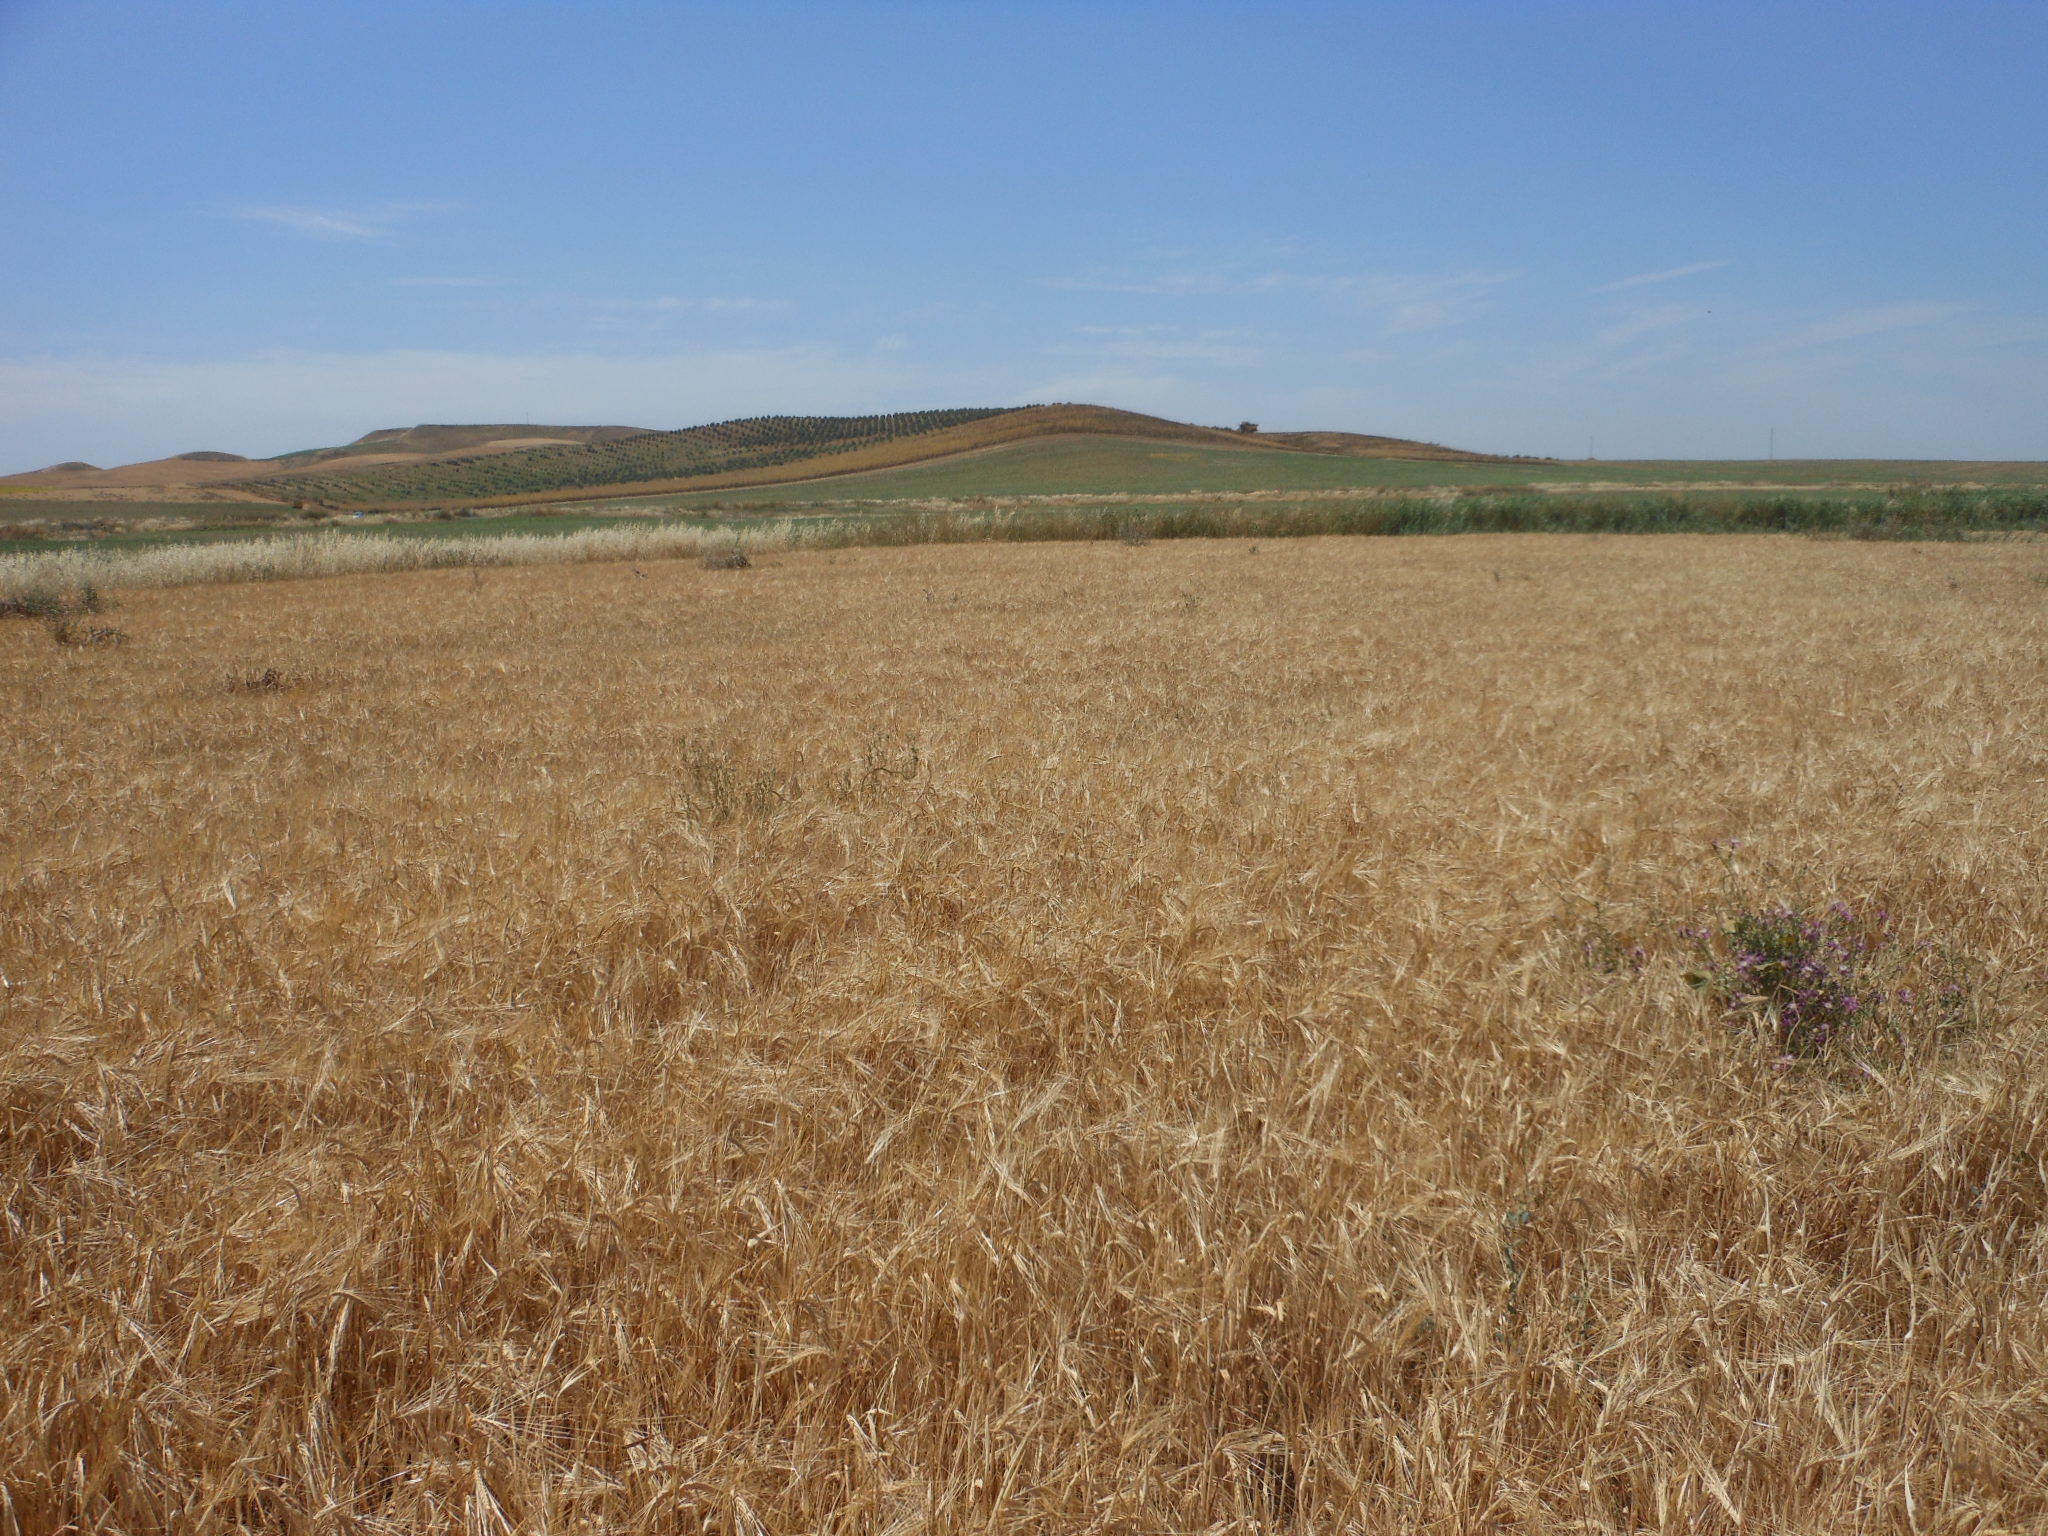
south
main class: Cropland
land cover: Barley
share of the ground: > 75 %
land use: Agriculture (excluding fallow land and kitchen gardens)
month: May
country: ES
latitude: 37.4606
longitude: -5.4027
